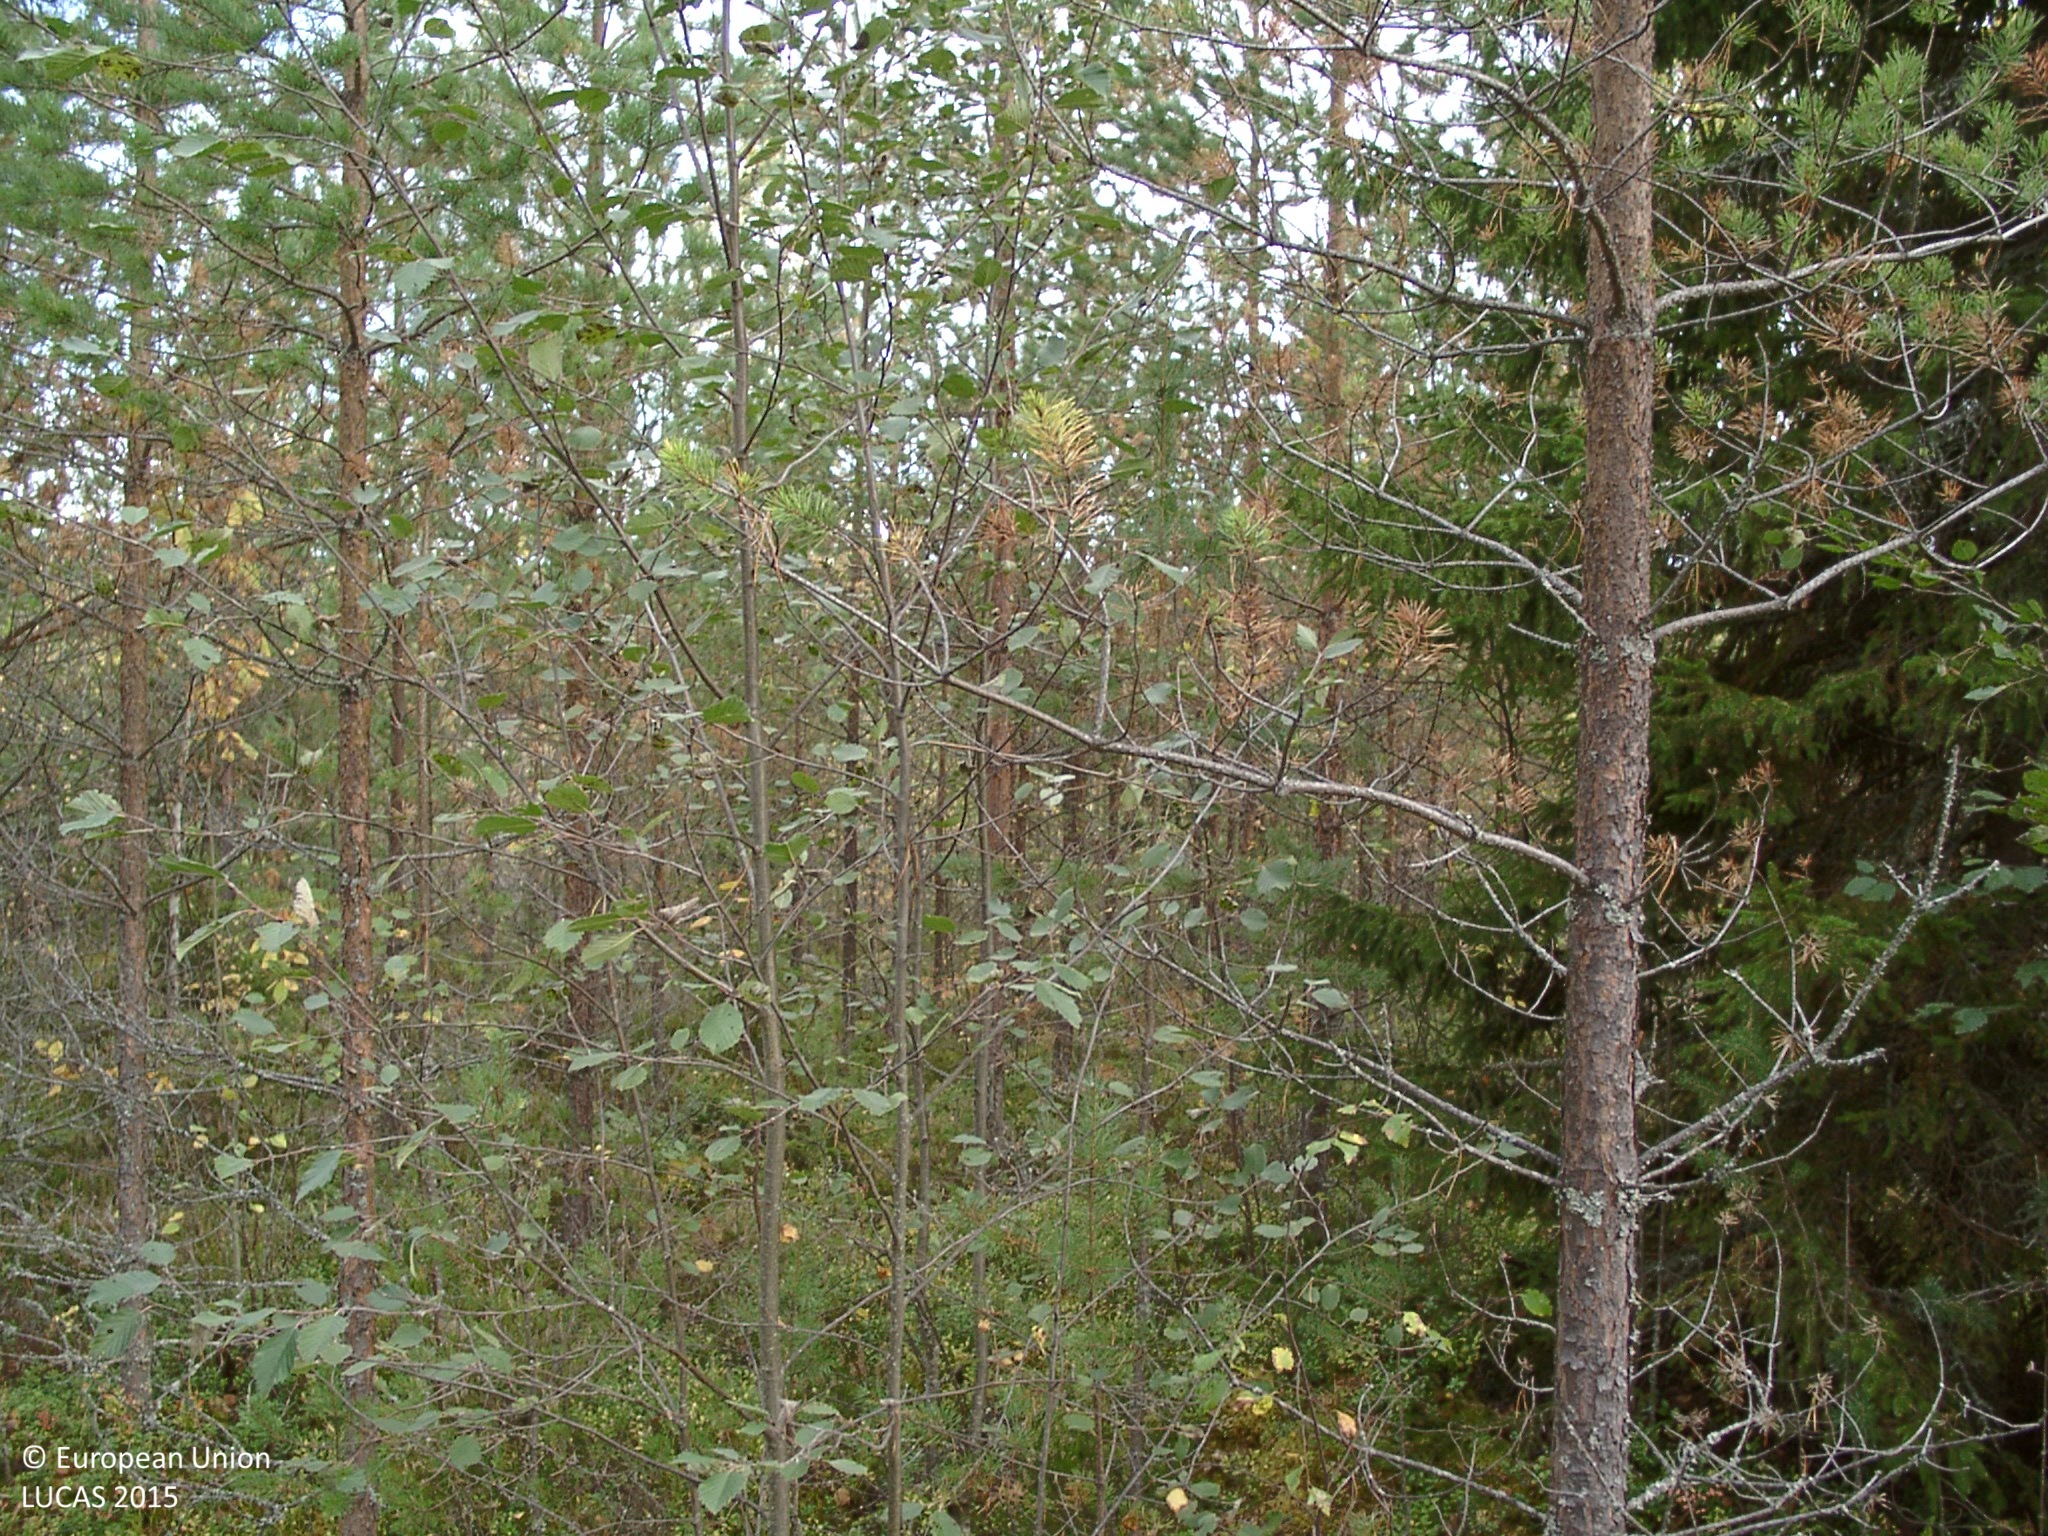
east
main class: Woodland
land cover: Pine dominated mixed woodland
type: boreal forest
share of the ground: 50 - 75 %
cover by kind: coniferous forest trees 45 %, shrubs 20 %, lichens and mosses 20 %, broadleaved forest trees 15 %
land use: Forestry
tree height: < 5 m
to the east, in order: Pine dominated mixed woodland; Broadleaved woodland; Ditches and canals; Spruce dominated mixed woodland; Ditches and canals; Spruce dominated mixed woodland; Ditches and canals; Spruce dominated mixed woodland; Broadleaved woodland; Spruce dominated mixed woodland; Ditches and canals; Spruce dominated mixed woodland
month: September
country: FI
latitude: 62.6759
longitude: 25.4377
